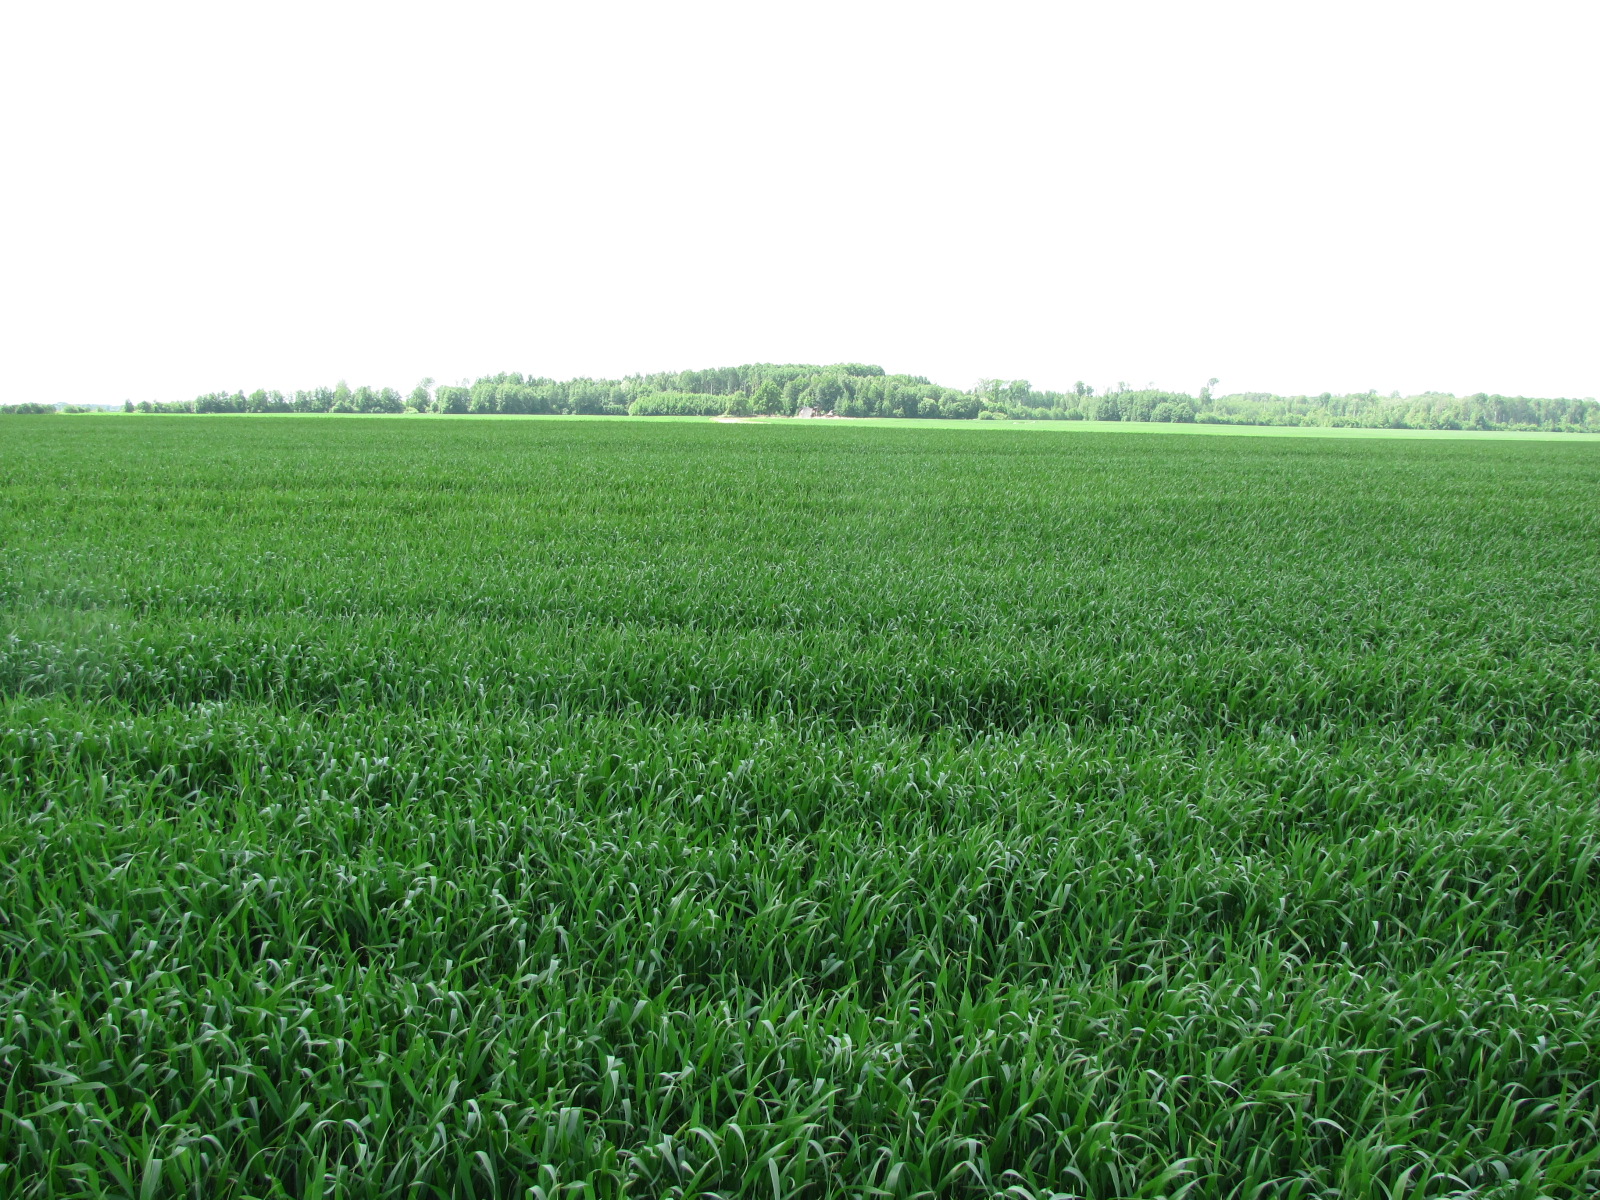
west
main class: Cropland
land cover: Common wheat
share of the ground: > 75 %
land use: Agriculture (excluding fallow land and kitchen gardens)
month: June
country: LV
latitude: 56.2542
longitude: 24.1811
